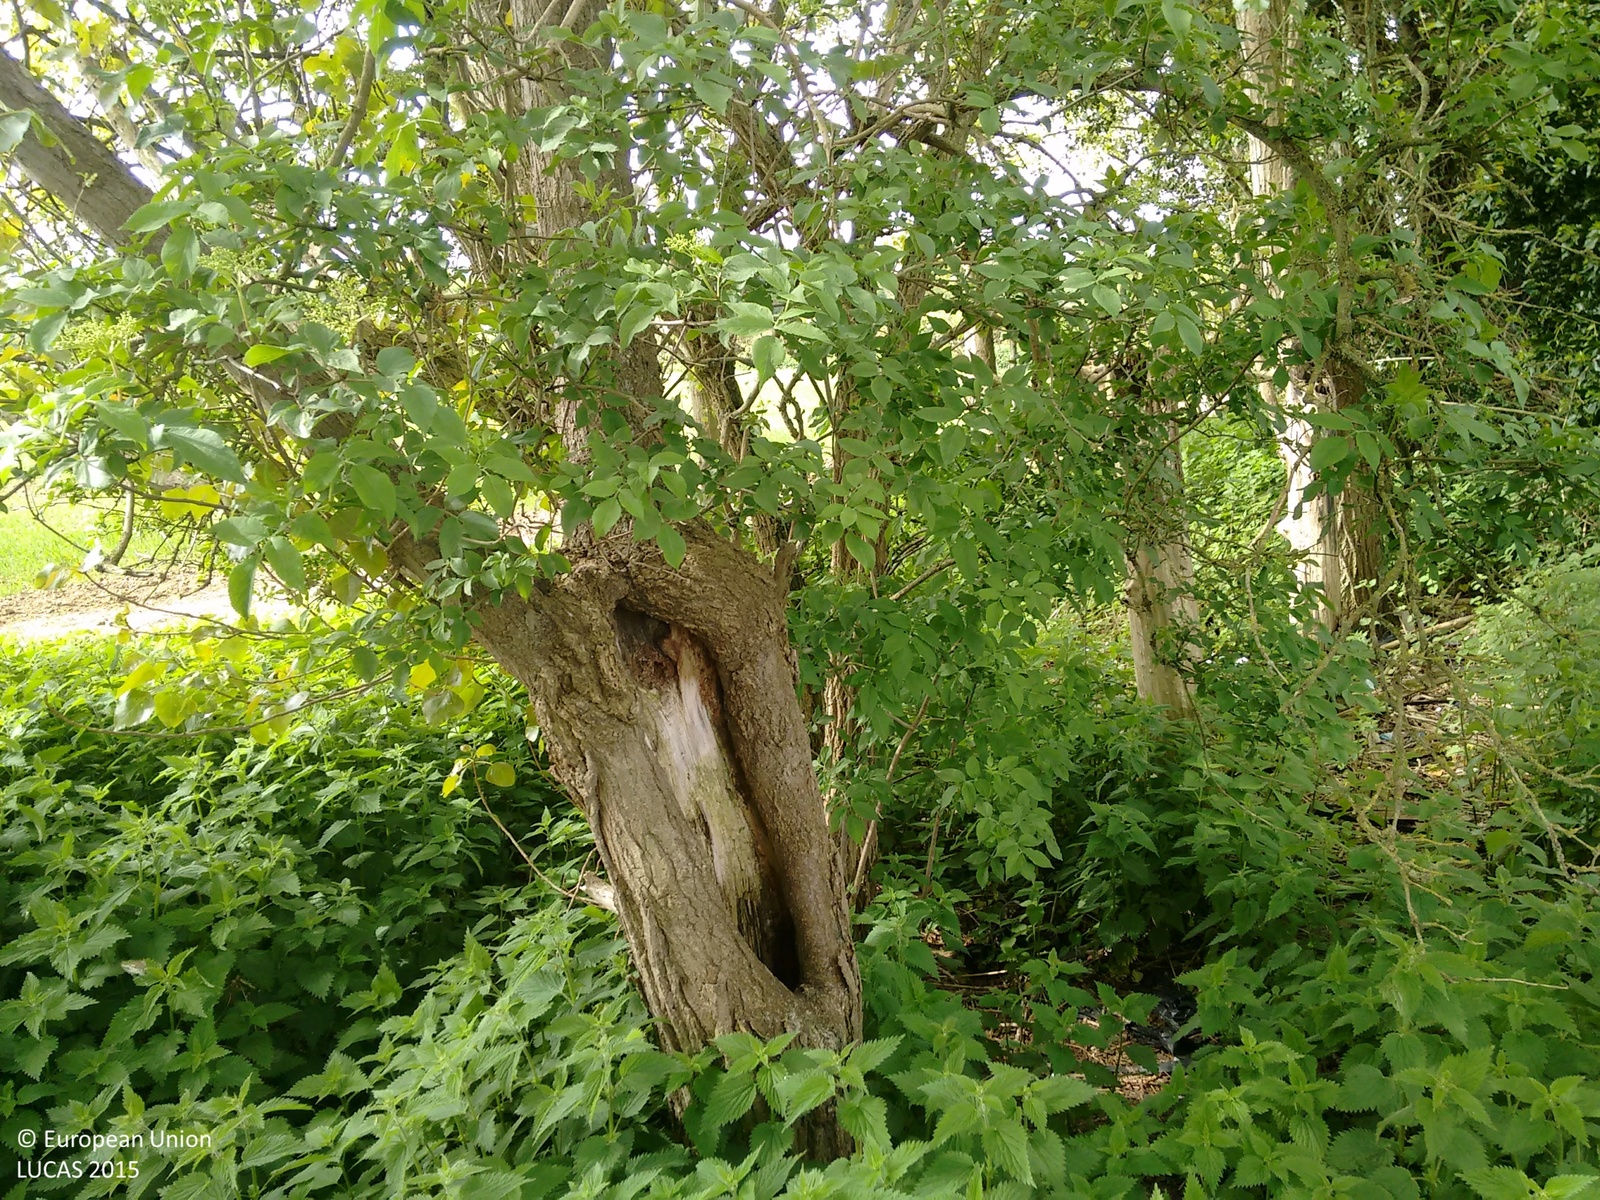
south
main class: Woodland
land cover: Broadleaved woodland
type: mesophytic deciduous forest
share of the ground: > 75 %
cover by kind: broadleaved forest trees 85 %, herbaceous plants 10 %, shrubs 5 %
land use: Forestry
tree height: > 5 m
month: May
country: GB
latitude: 51.2643
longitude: 0.4122
